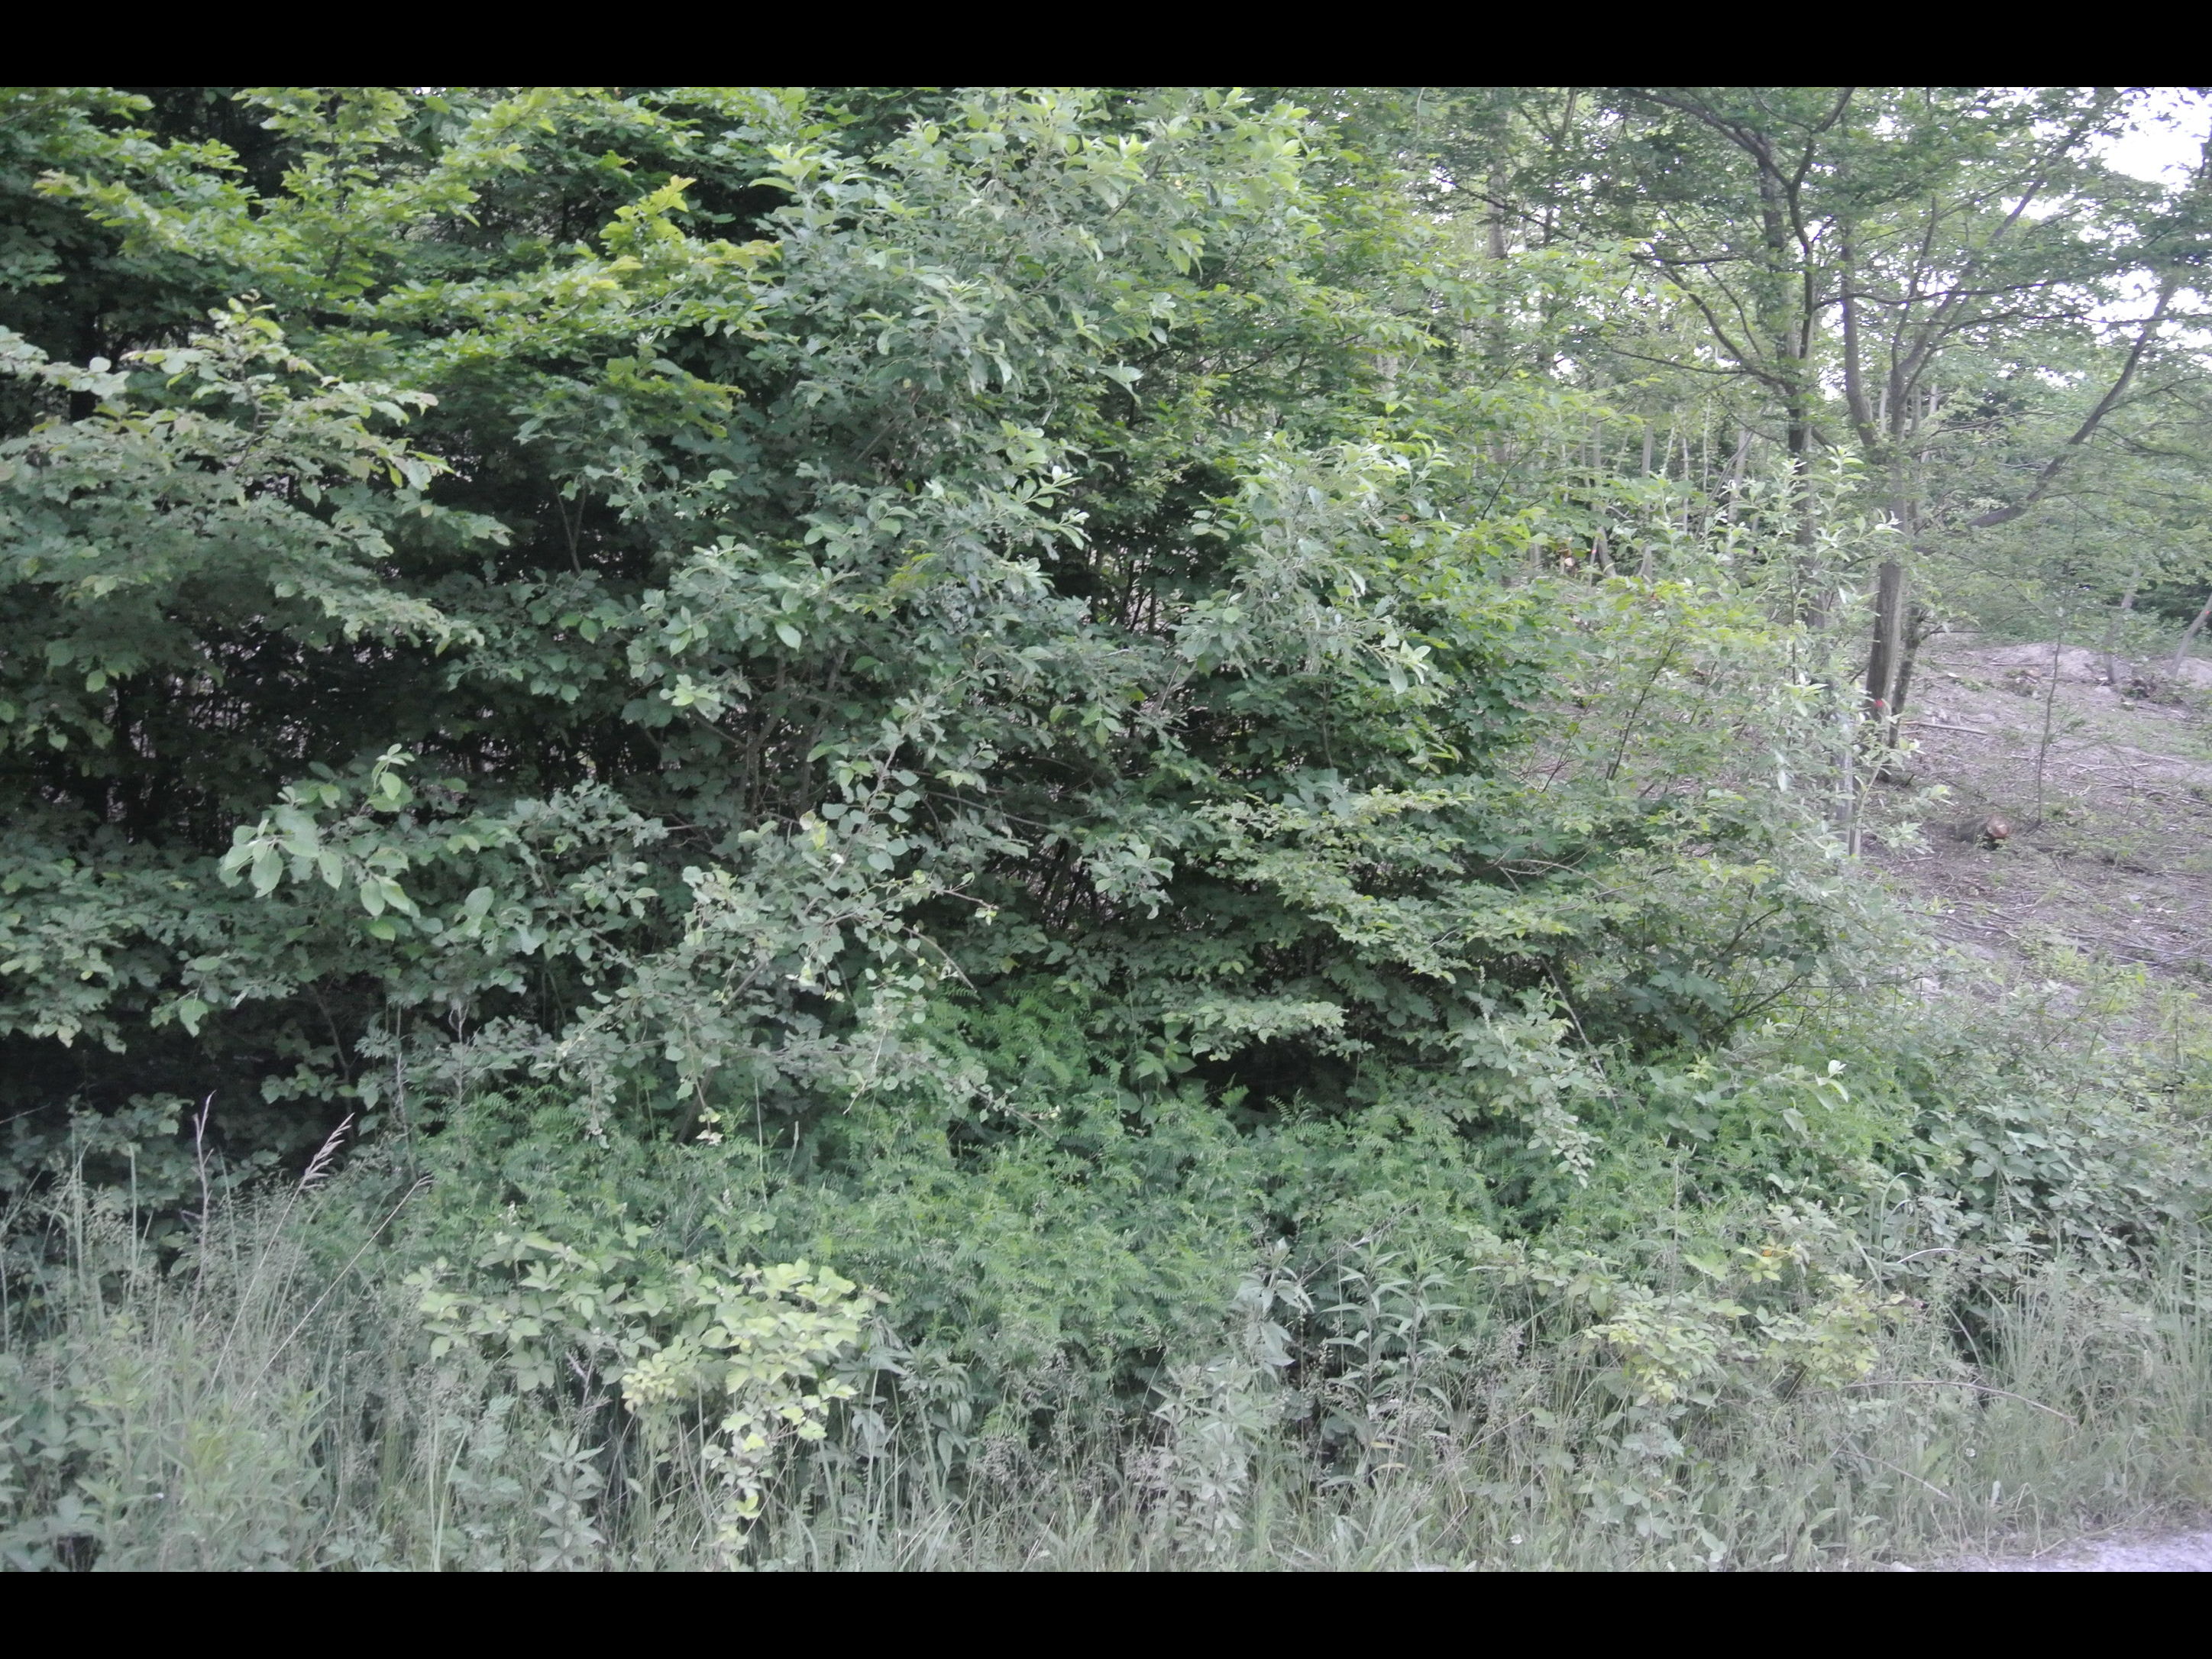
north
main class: Woodland
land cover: Broadleaved woodland
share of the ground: 50 - 75 %
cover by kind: broadleaved forest trees 75 %, herbaceous plants 25 %
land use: Forestry
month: June
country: AT
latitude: 47.8830
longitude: 16.5709
